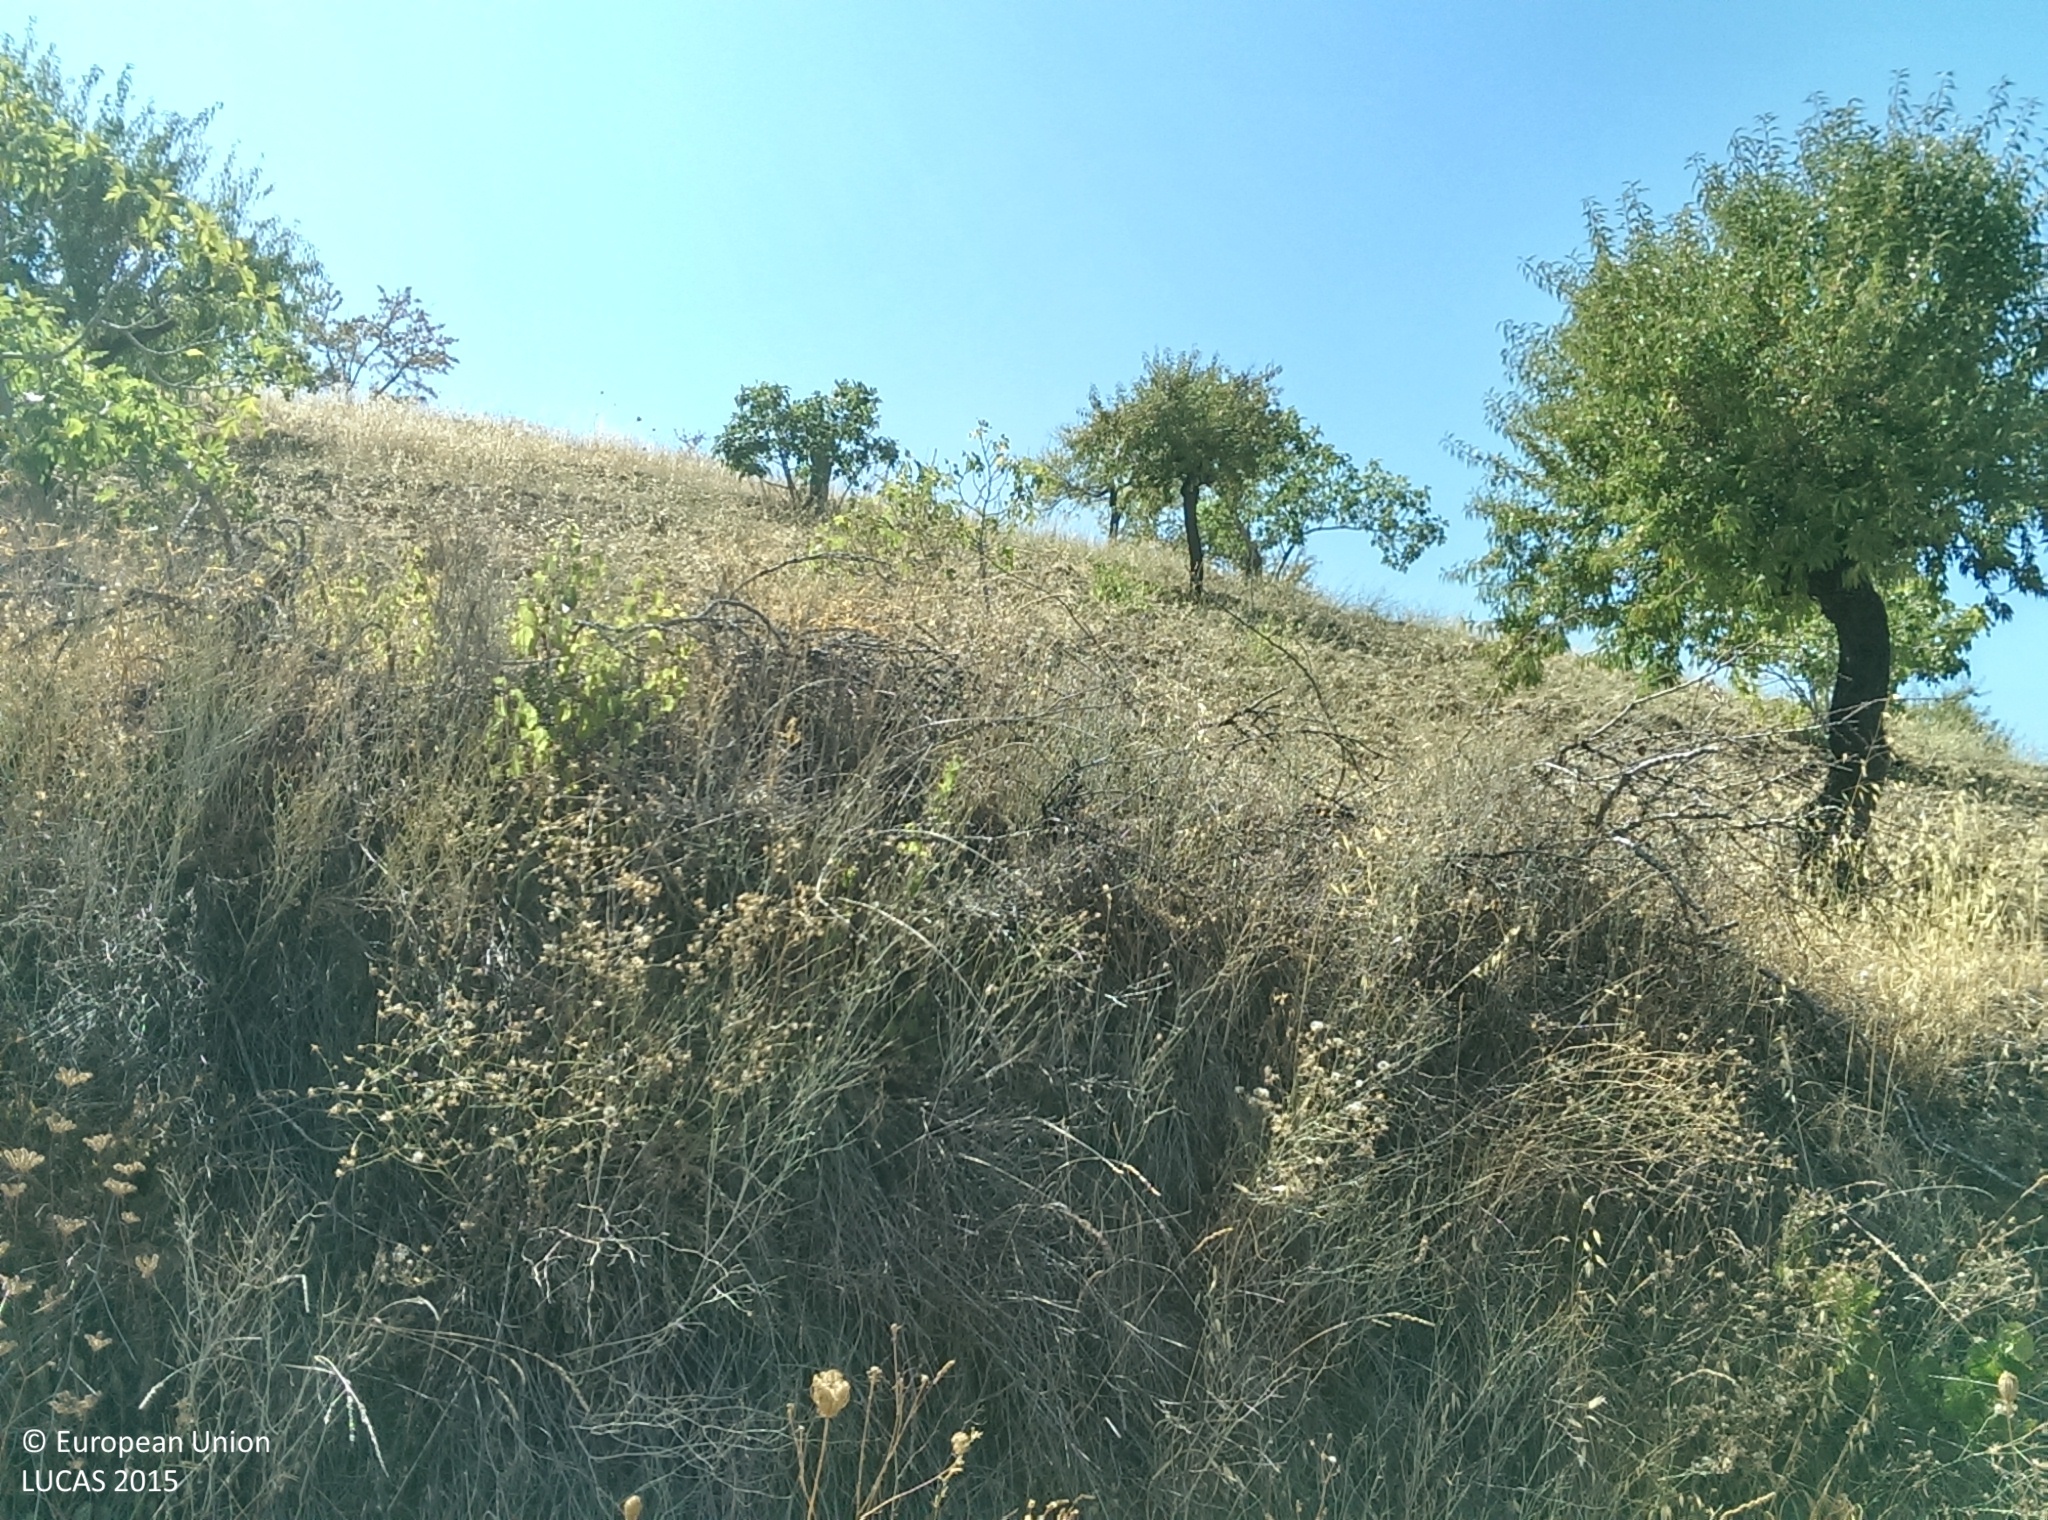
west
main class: Woodland
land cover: Broadleaved woodland
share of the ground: 25 - 50 %
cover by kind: broadleaved forest trees 40 %, herbaceous plants 30 %, shrubs 20 %, unconsolidated bare surface 10 %
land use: Semi-natural and natural areas not in use
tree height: > 5 m
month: August
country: ES
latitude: 36.8948
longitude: -3.2115
